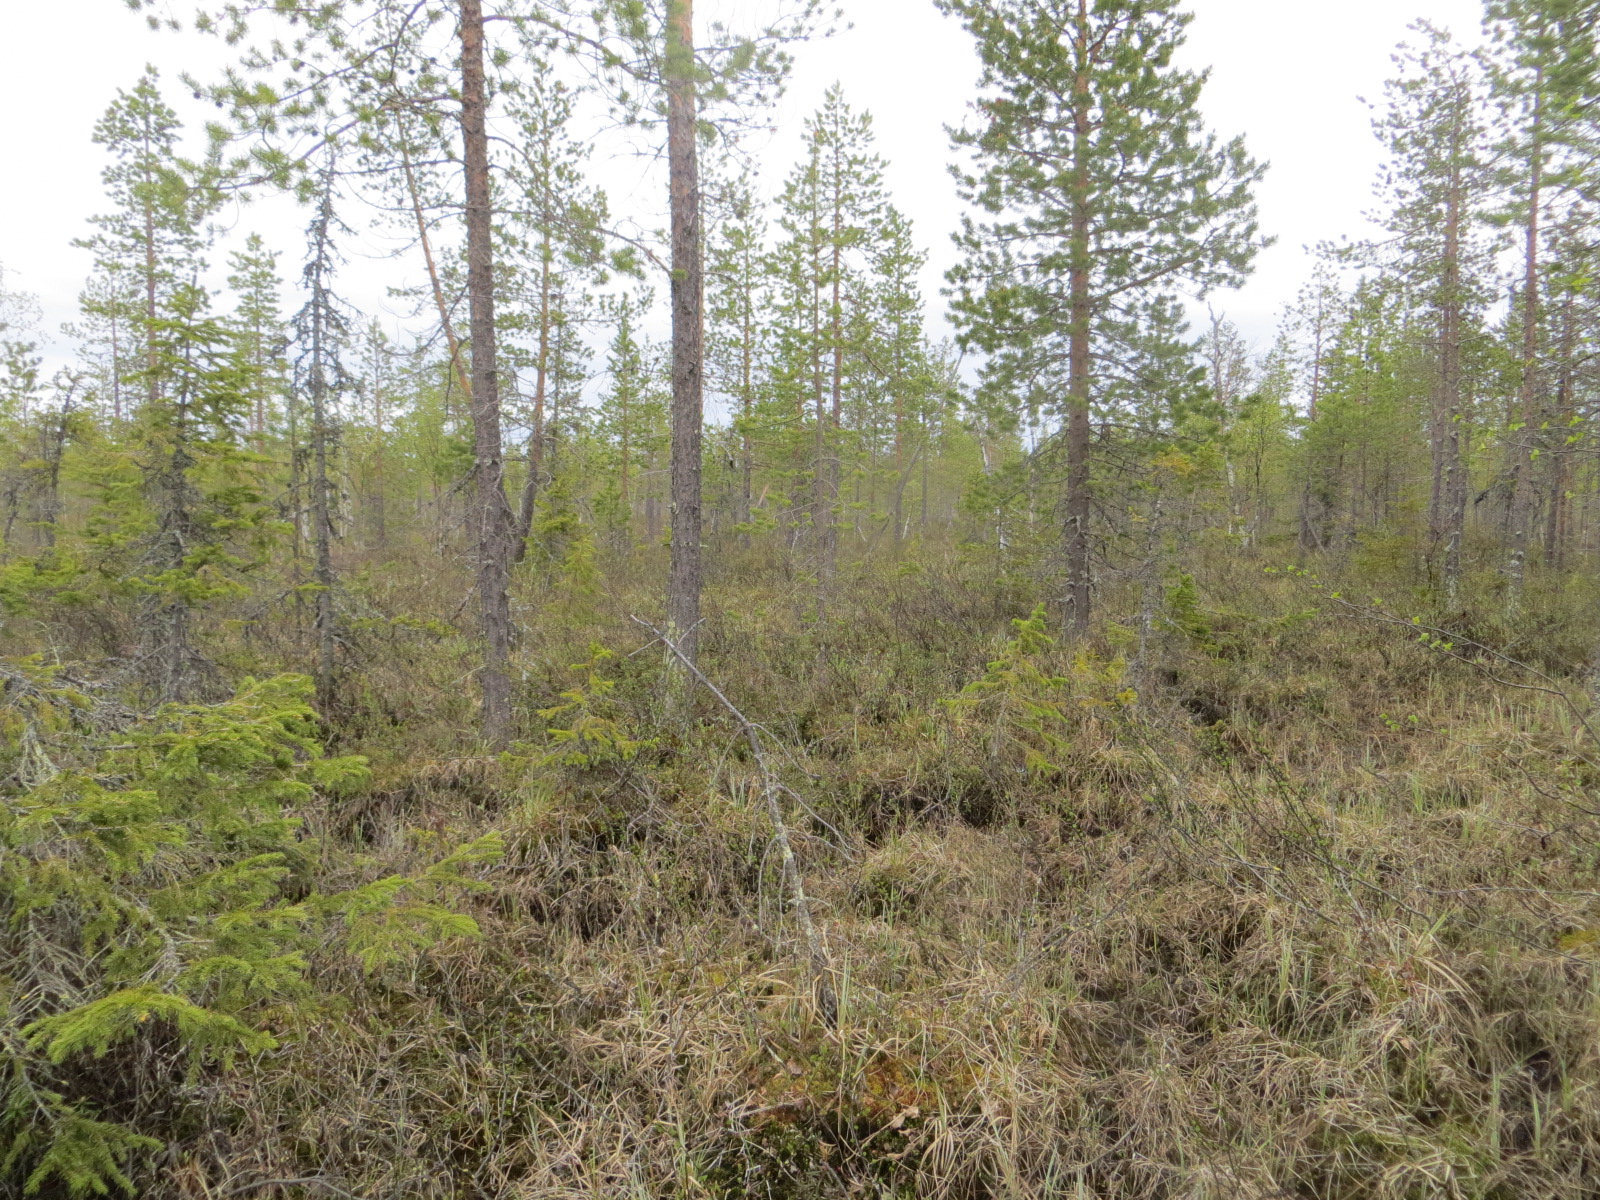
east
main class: Woodland
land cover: Pine dominated mixed woodland
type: mire and swamp forests
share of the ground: > 75 %
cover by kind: coniferous forest trees 55 %, broadleaved forest trees 25 %, shrubs 10 %, herbaceous plants 10 %
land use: Semi-natural and natural areas not in use
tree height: > 5 m
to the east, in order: Pine dominated mixed woodland; Broadleaved woodland; Inland marshes; Rivers and streams; Inland marshes; Pine dominated mixed woodland
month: June
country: FI
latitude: 67.7401
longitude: 25.1065
